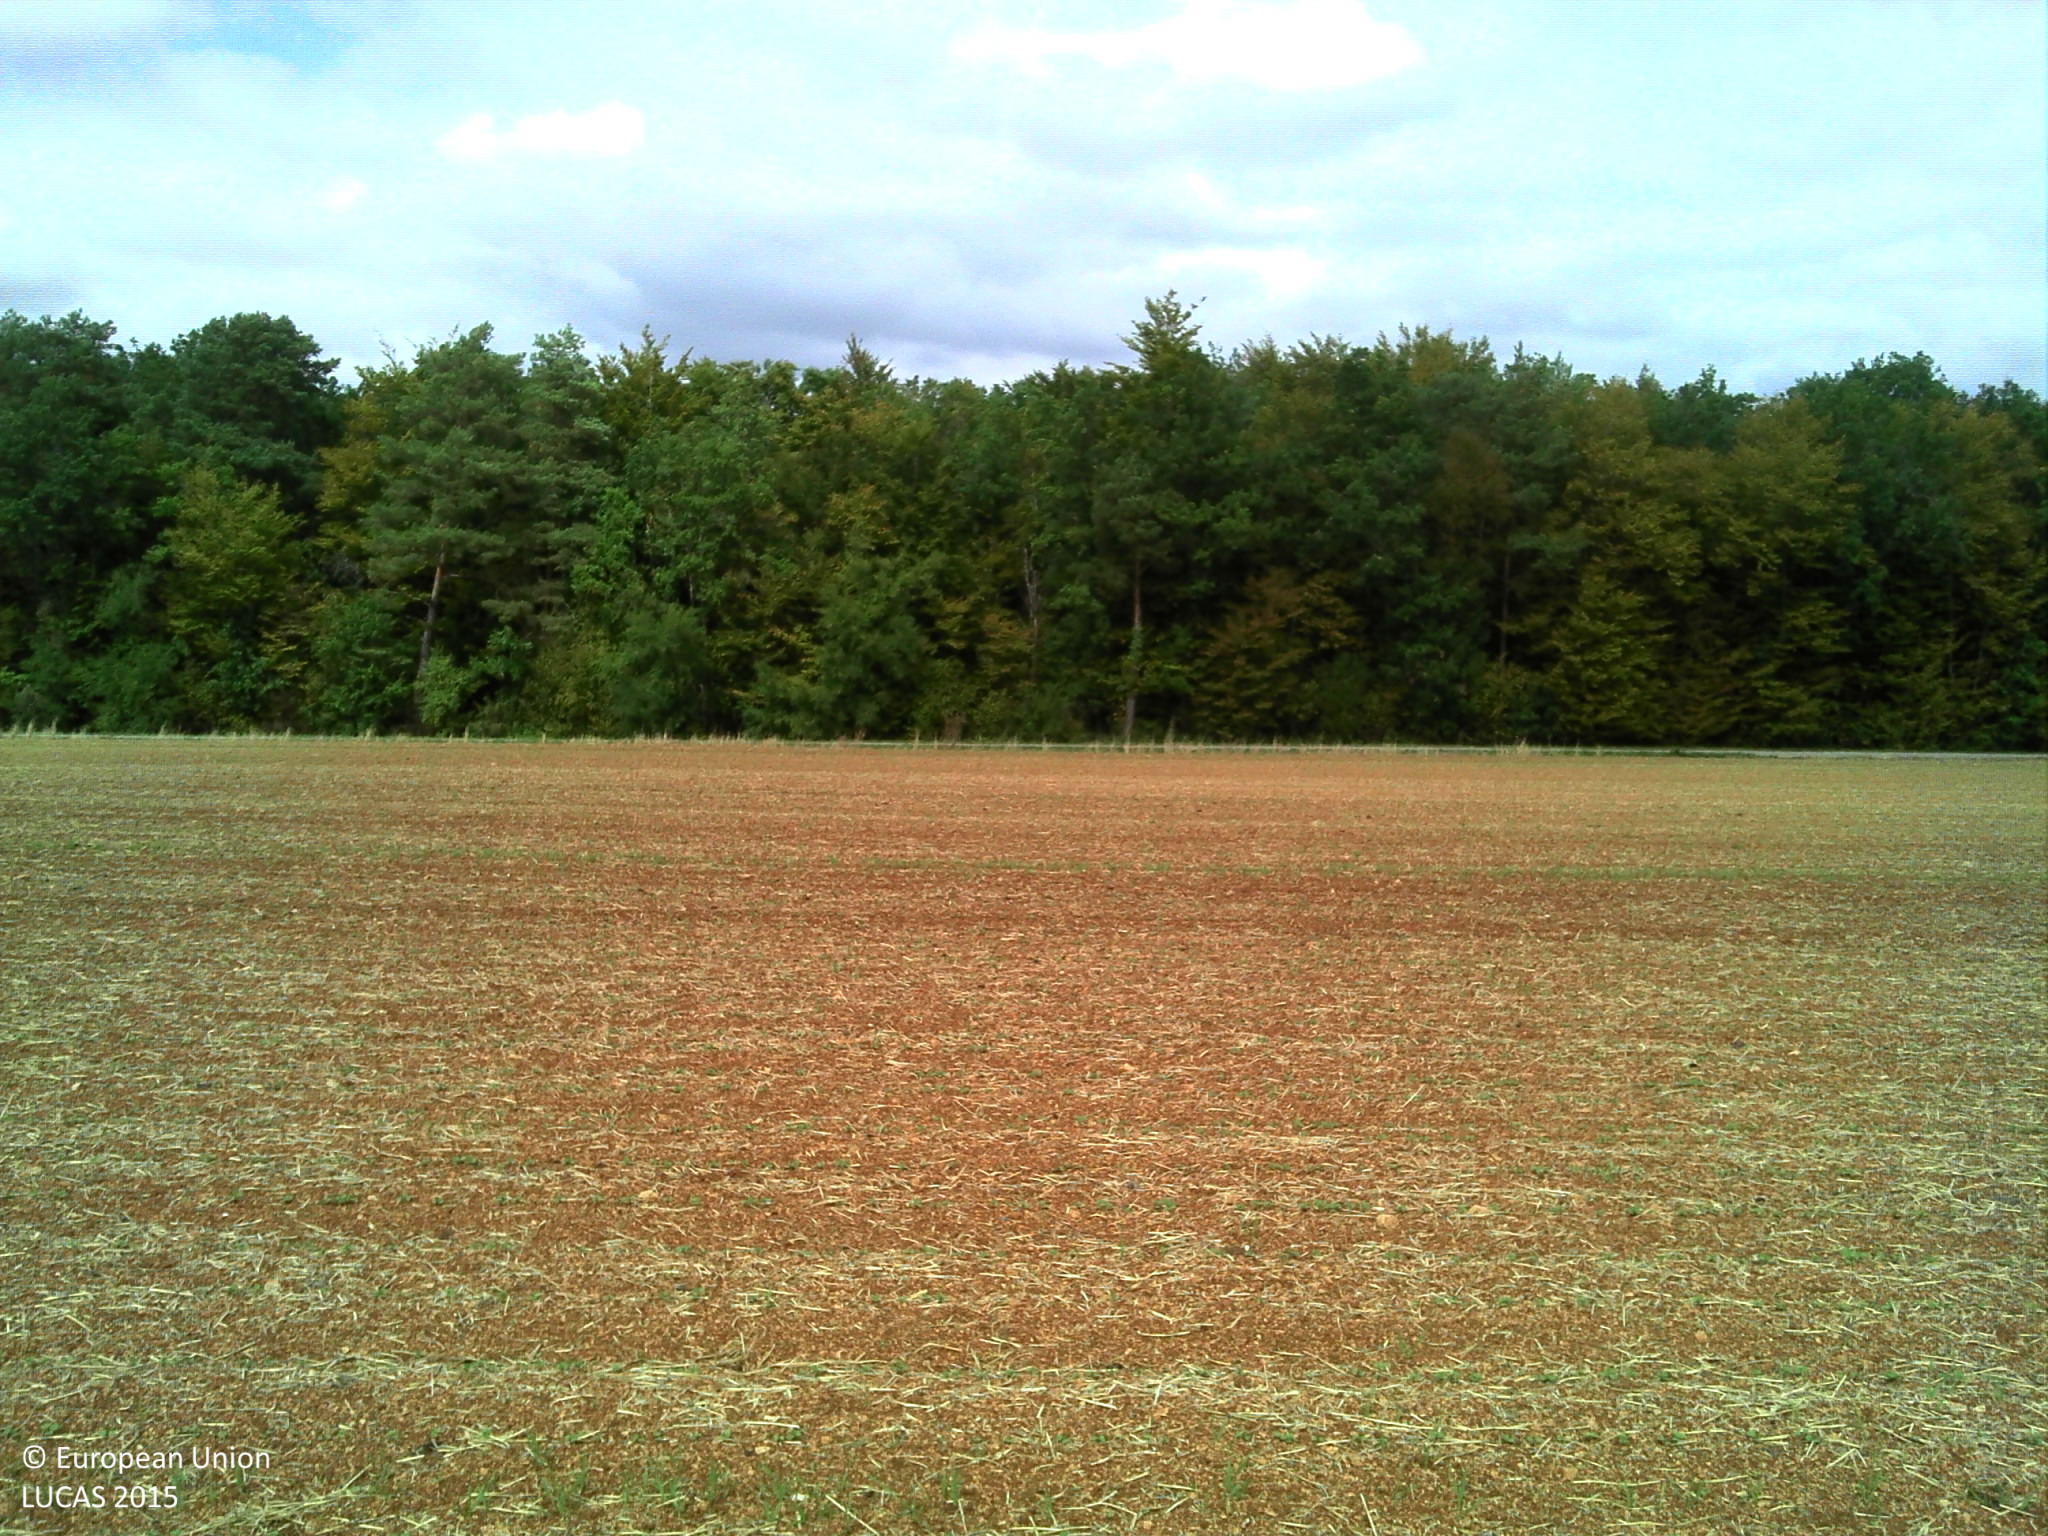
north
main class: Cropland
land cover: Barley
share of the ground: 10 - 25 %
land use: Agriculture (excluding fallow land and kitchen gardens)
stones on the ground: 10 - 25 %
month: September
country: FR
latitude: 47.5382
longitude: 4.7254
